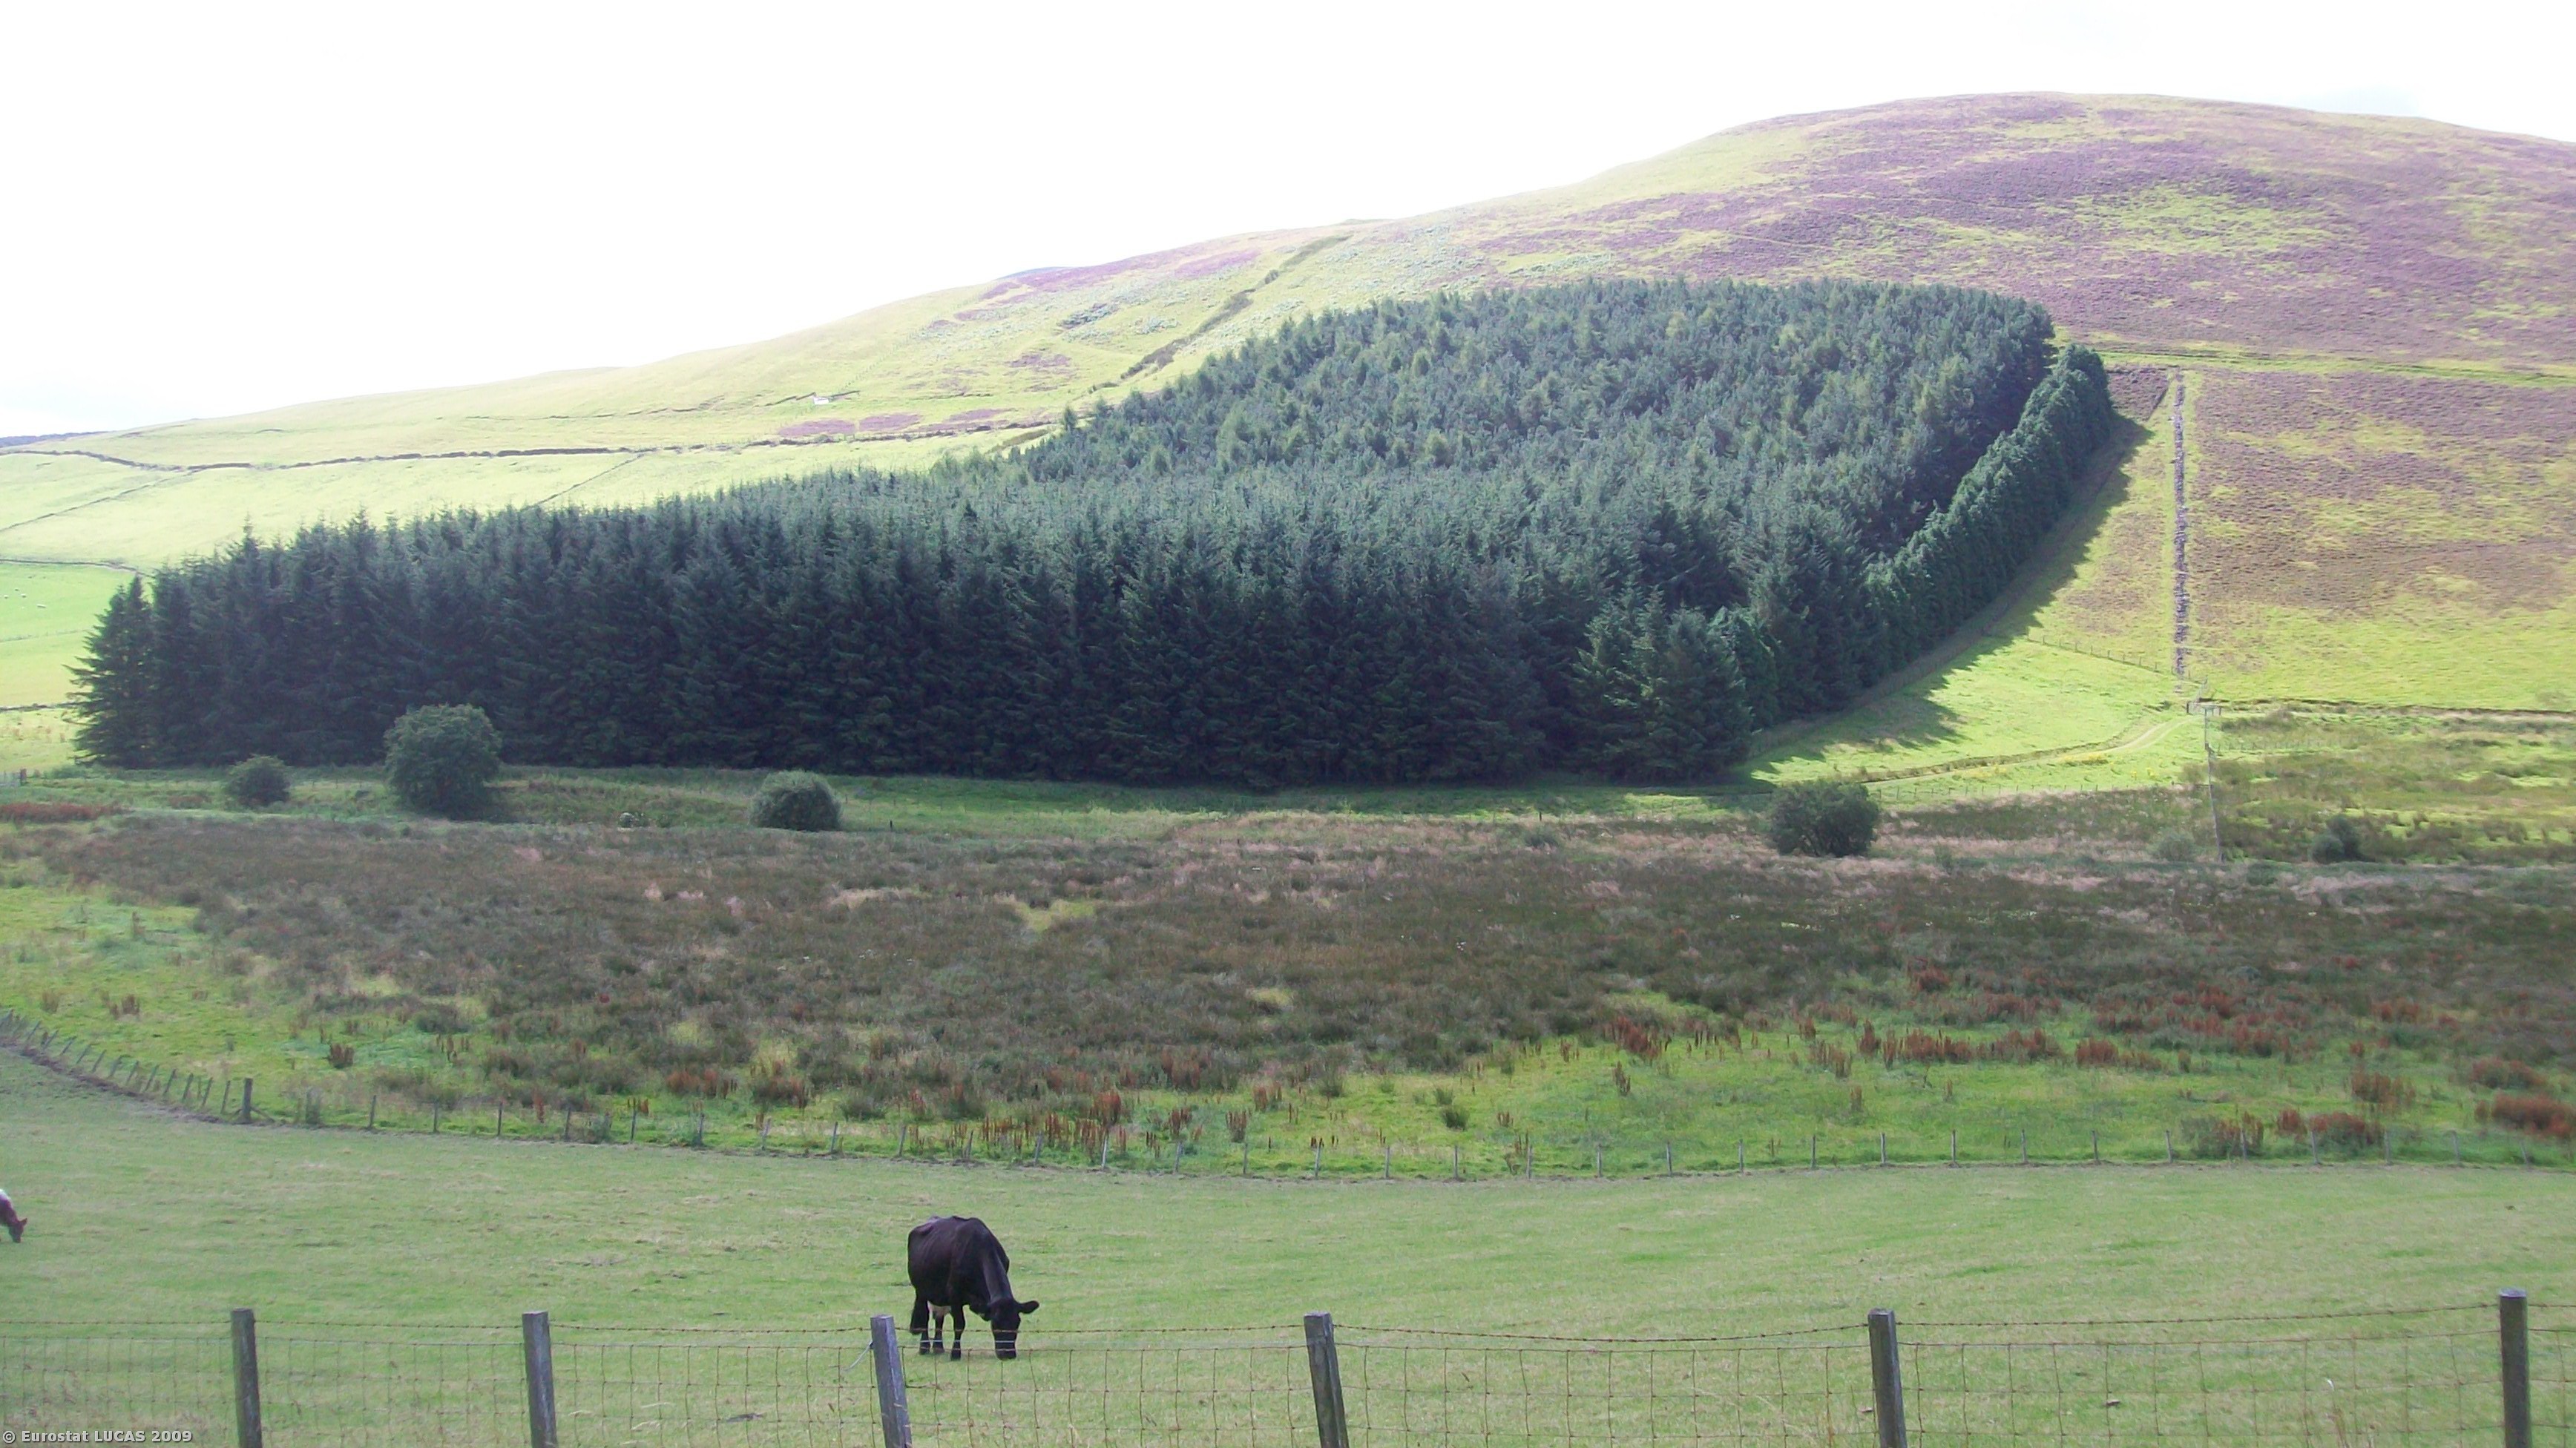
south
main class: Grassland
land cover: Grassland without tree/shrub cover
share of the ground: > 75 %
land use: Agriculture (excluding fallow land and kitchen gardens)
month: August
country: GB
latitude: 55.5989
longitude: -3.4891
